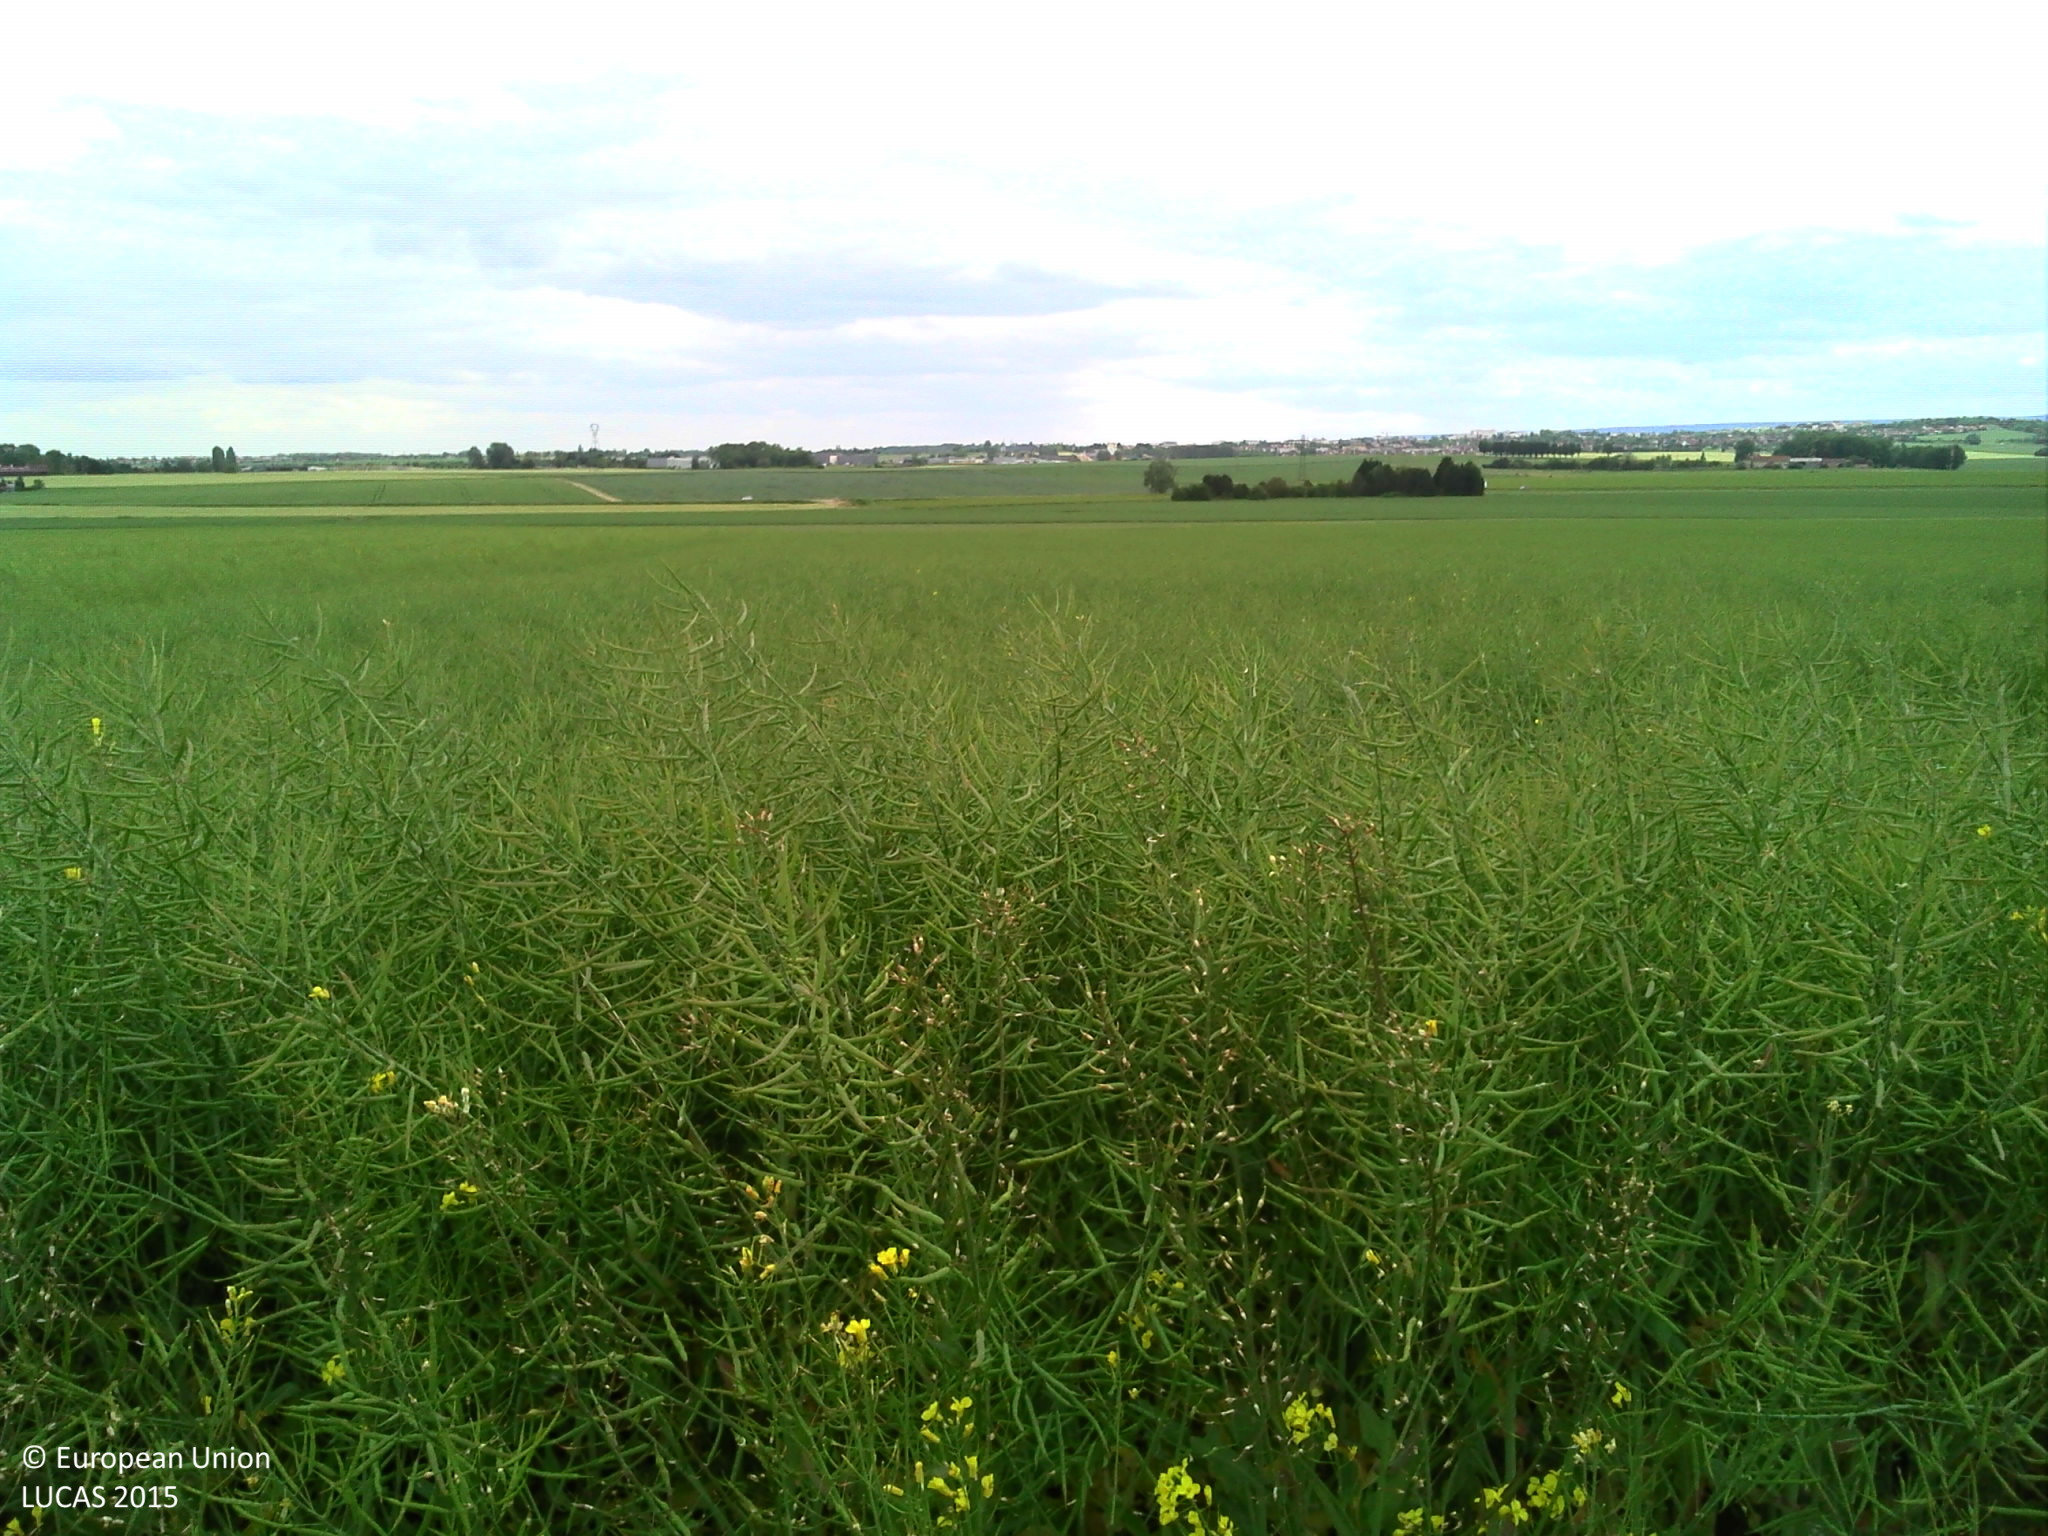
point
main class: Cropland
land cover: Rape and turnip rape
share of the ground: > 75 %
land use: Agriculture (excluding fallow land and kitchen gardens)
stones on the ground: < 10 %
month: May
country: FR
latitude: 47.3580
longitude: 5.1151
